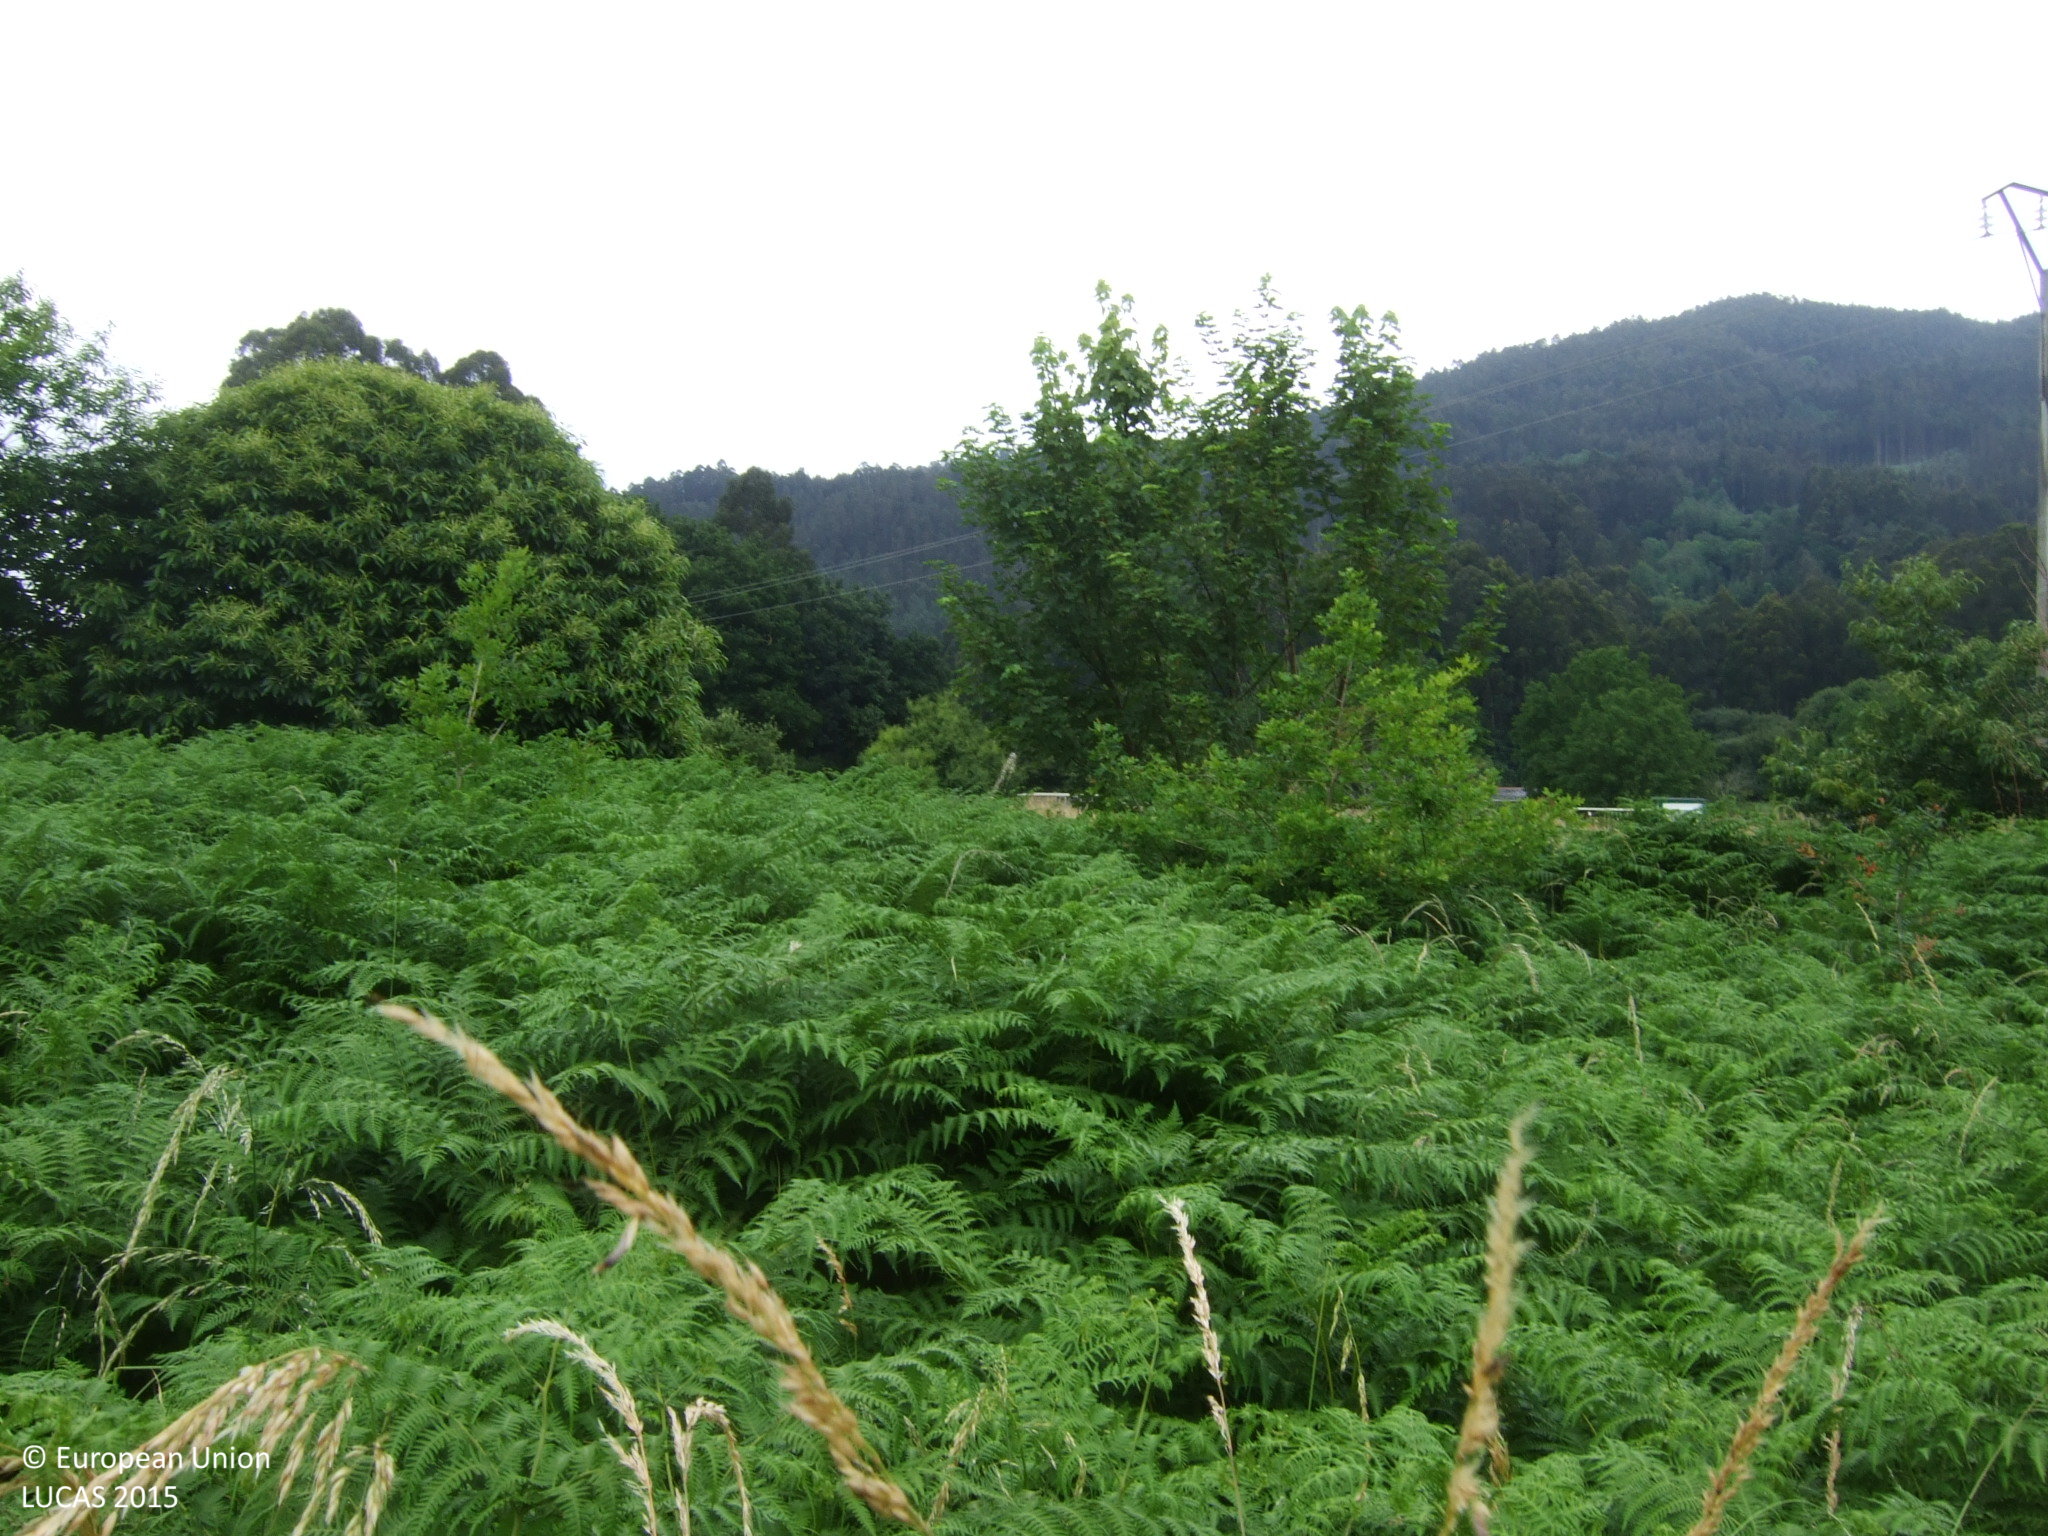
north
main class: Shrubland
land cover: Shrubland with sparse tree cover
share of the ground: > 75 %
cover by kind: shrubs 95 %, broadleaved forest trees 5 %
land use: Abandoned areas
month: June
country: ES
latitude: 43.6246
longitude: -7.5971
